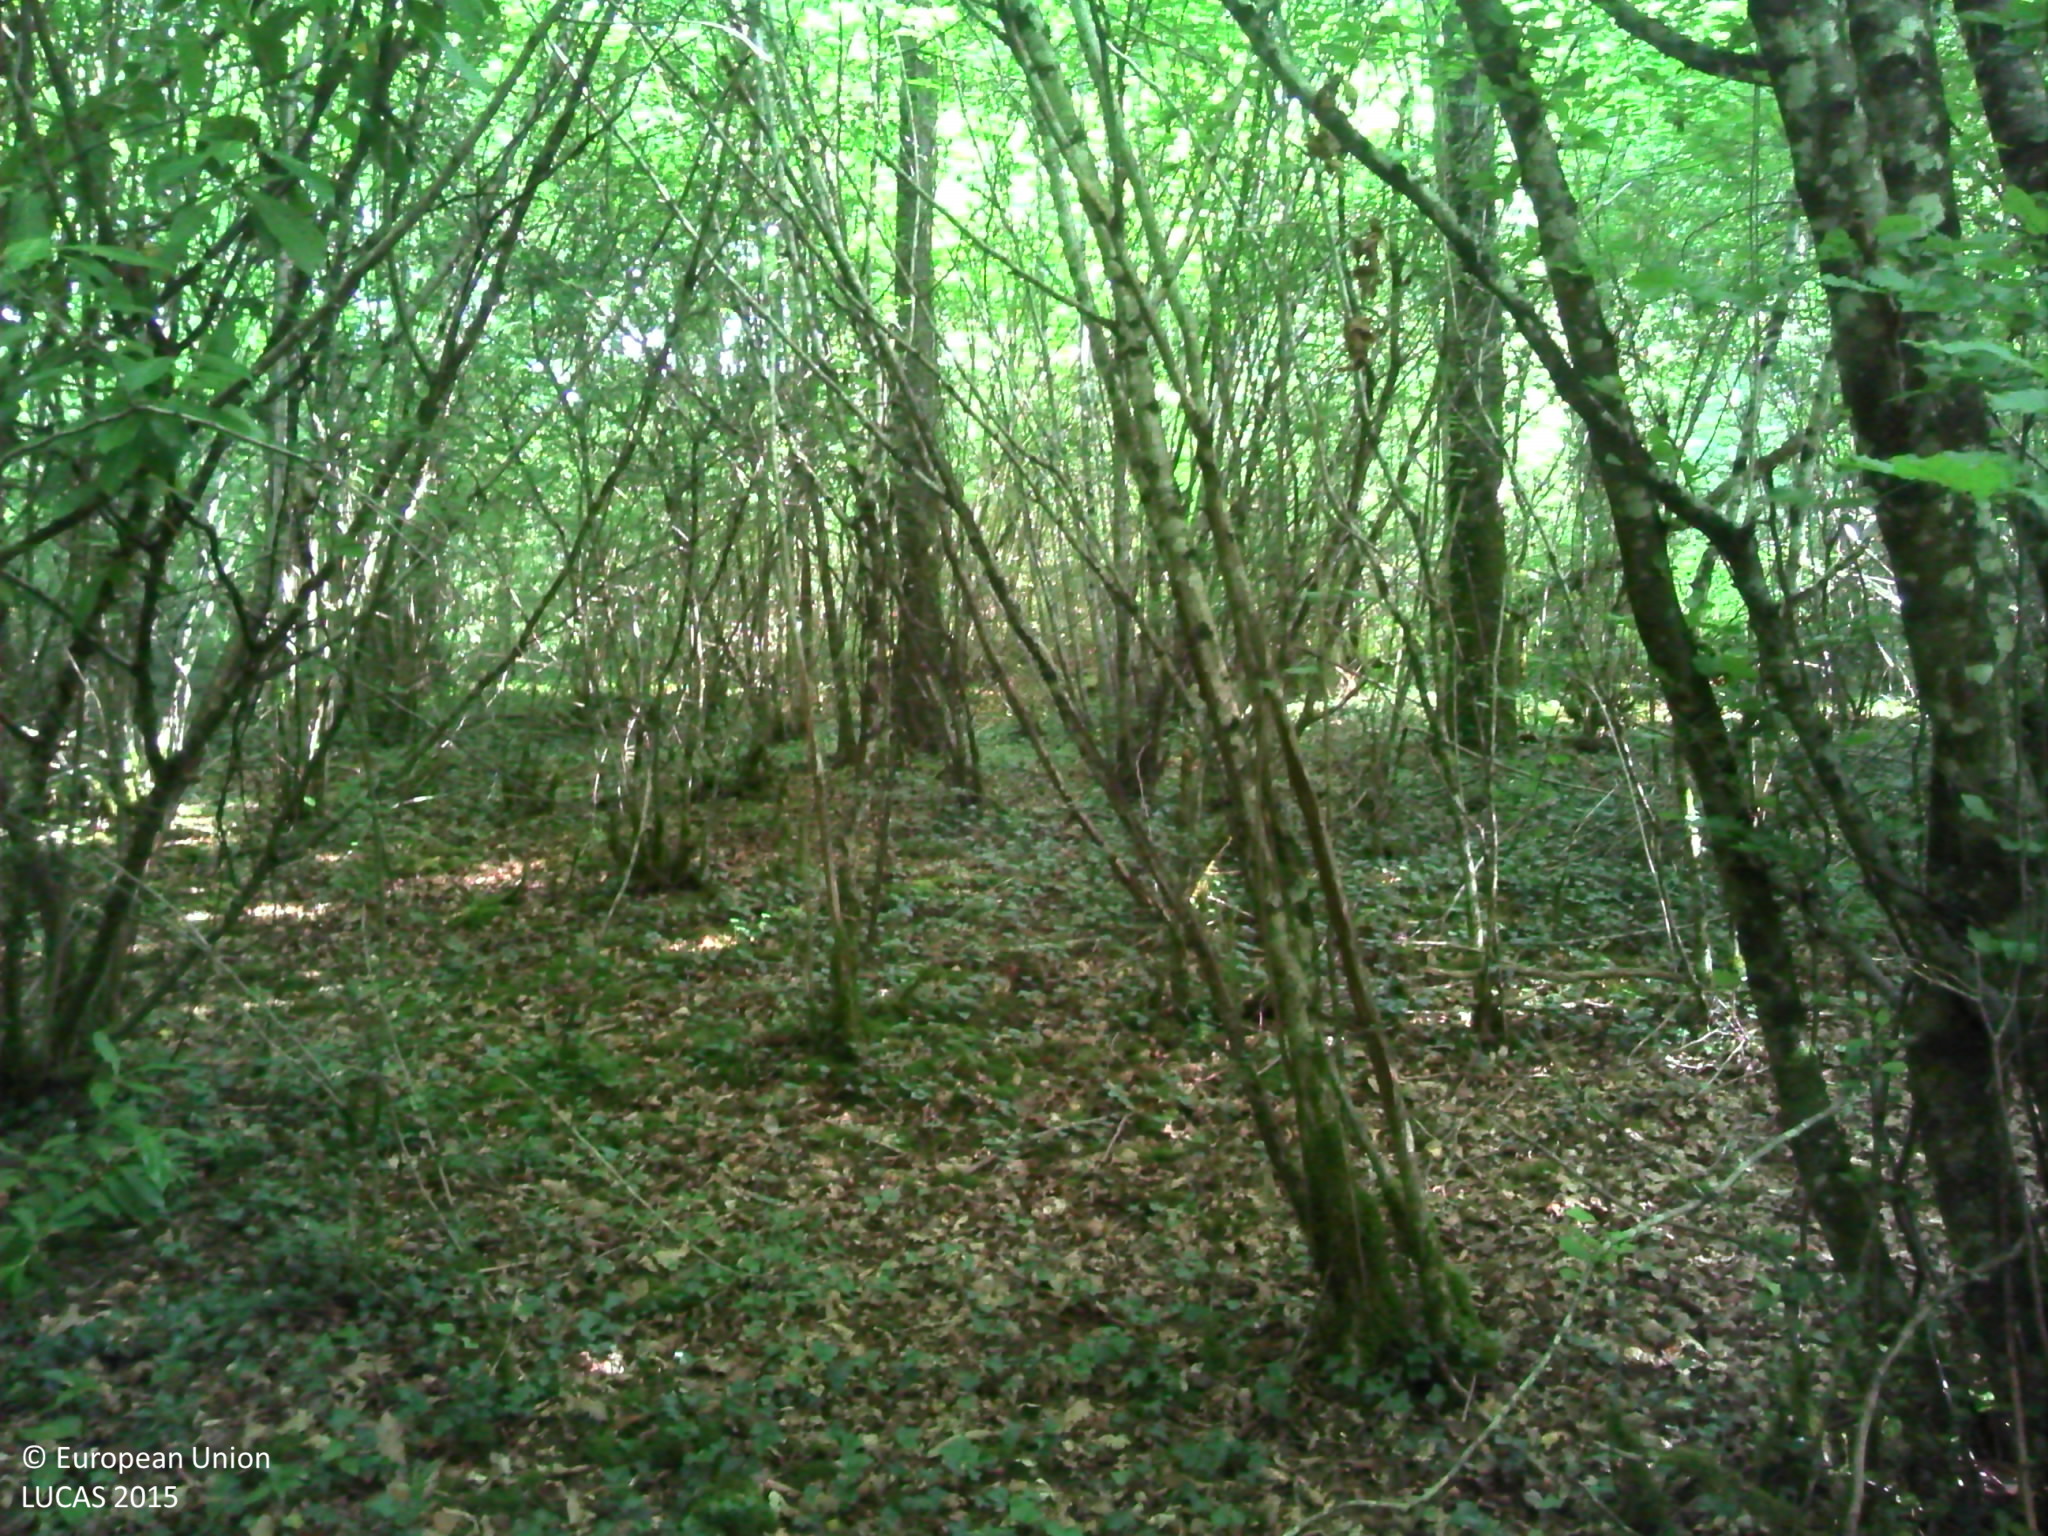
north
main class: Woodland
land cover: Broadleaved woodland
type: acidophilous oak and oak-birch forest
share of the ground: > 75 %
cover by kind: broadleaved forest trees 90 %, shrubs 5 %, herbaceous plants 5 %
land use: Forestry
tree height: > 5 m
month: June
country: FR
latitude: 46.5076
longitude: 0.2980
